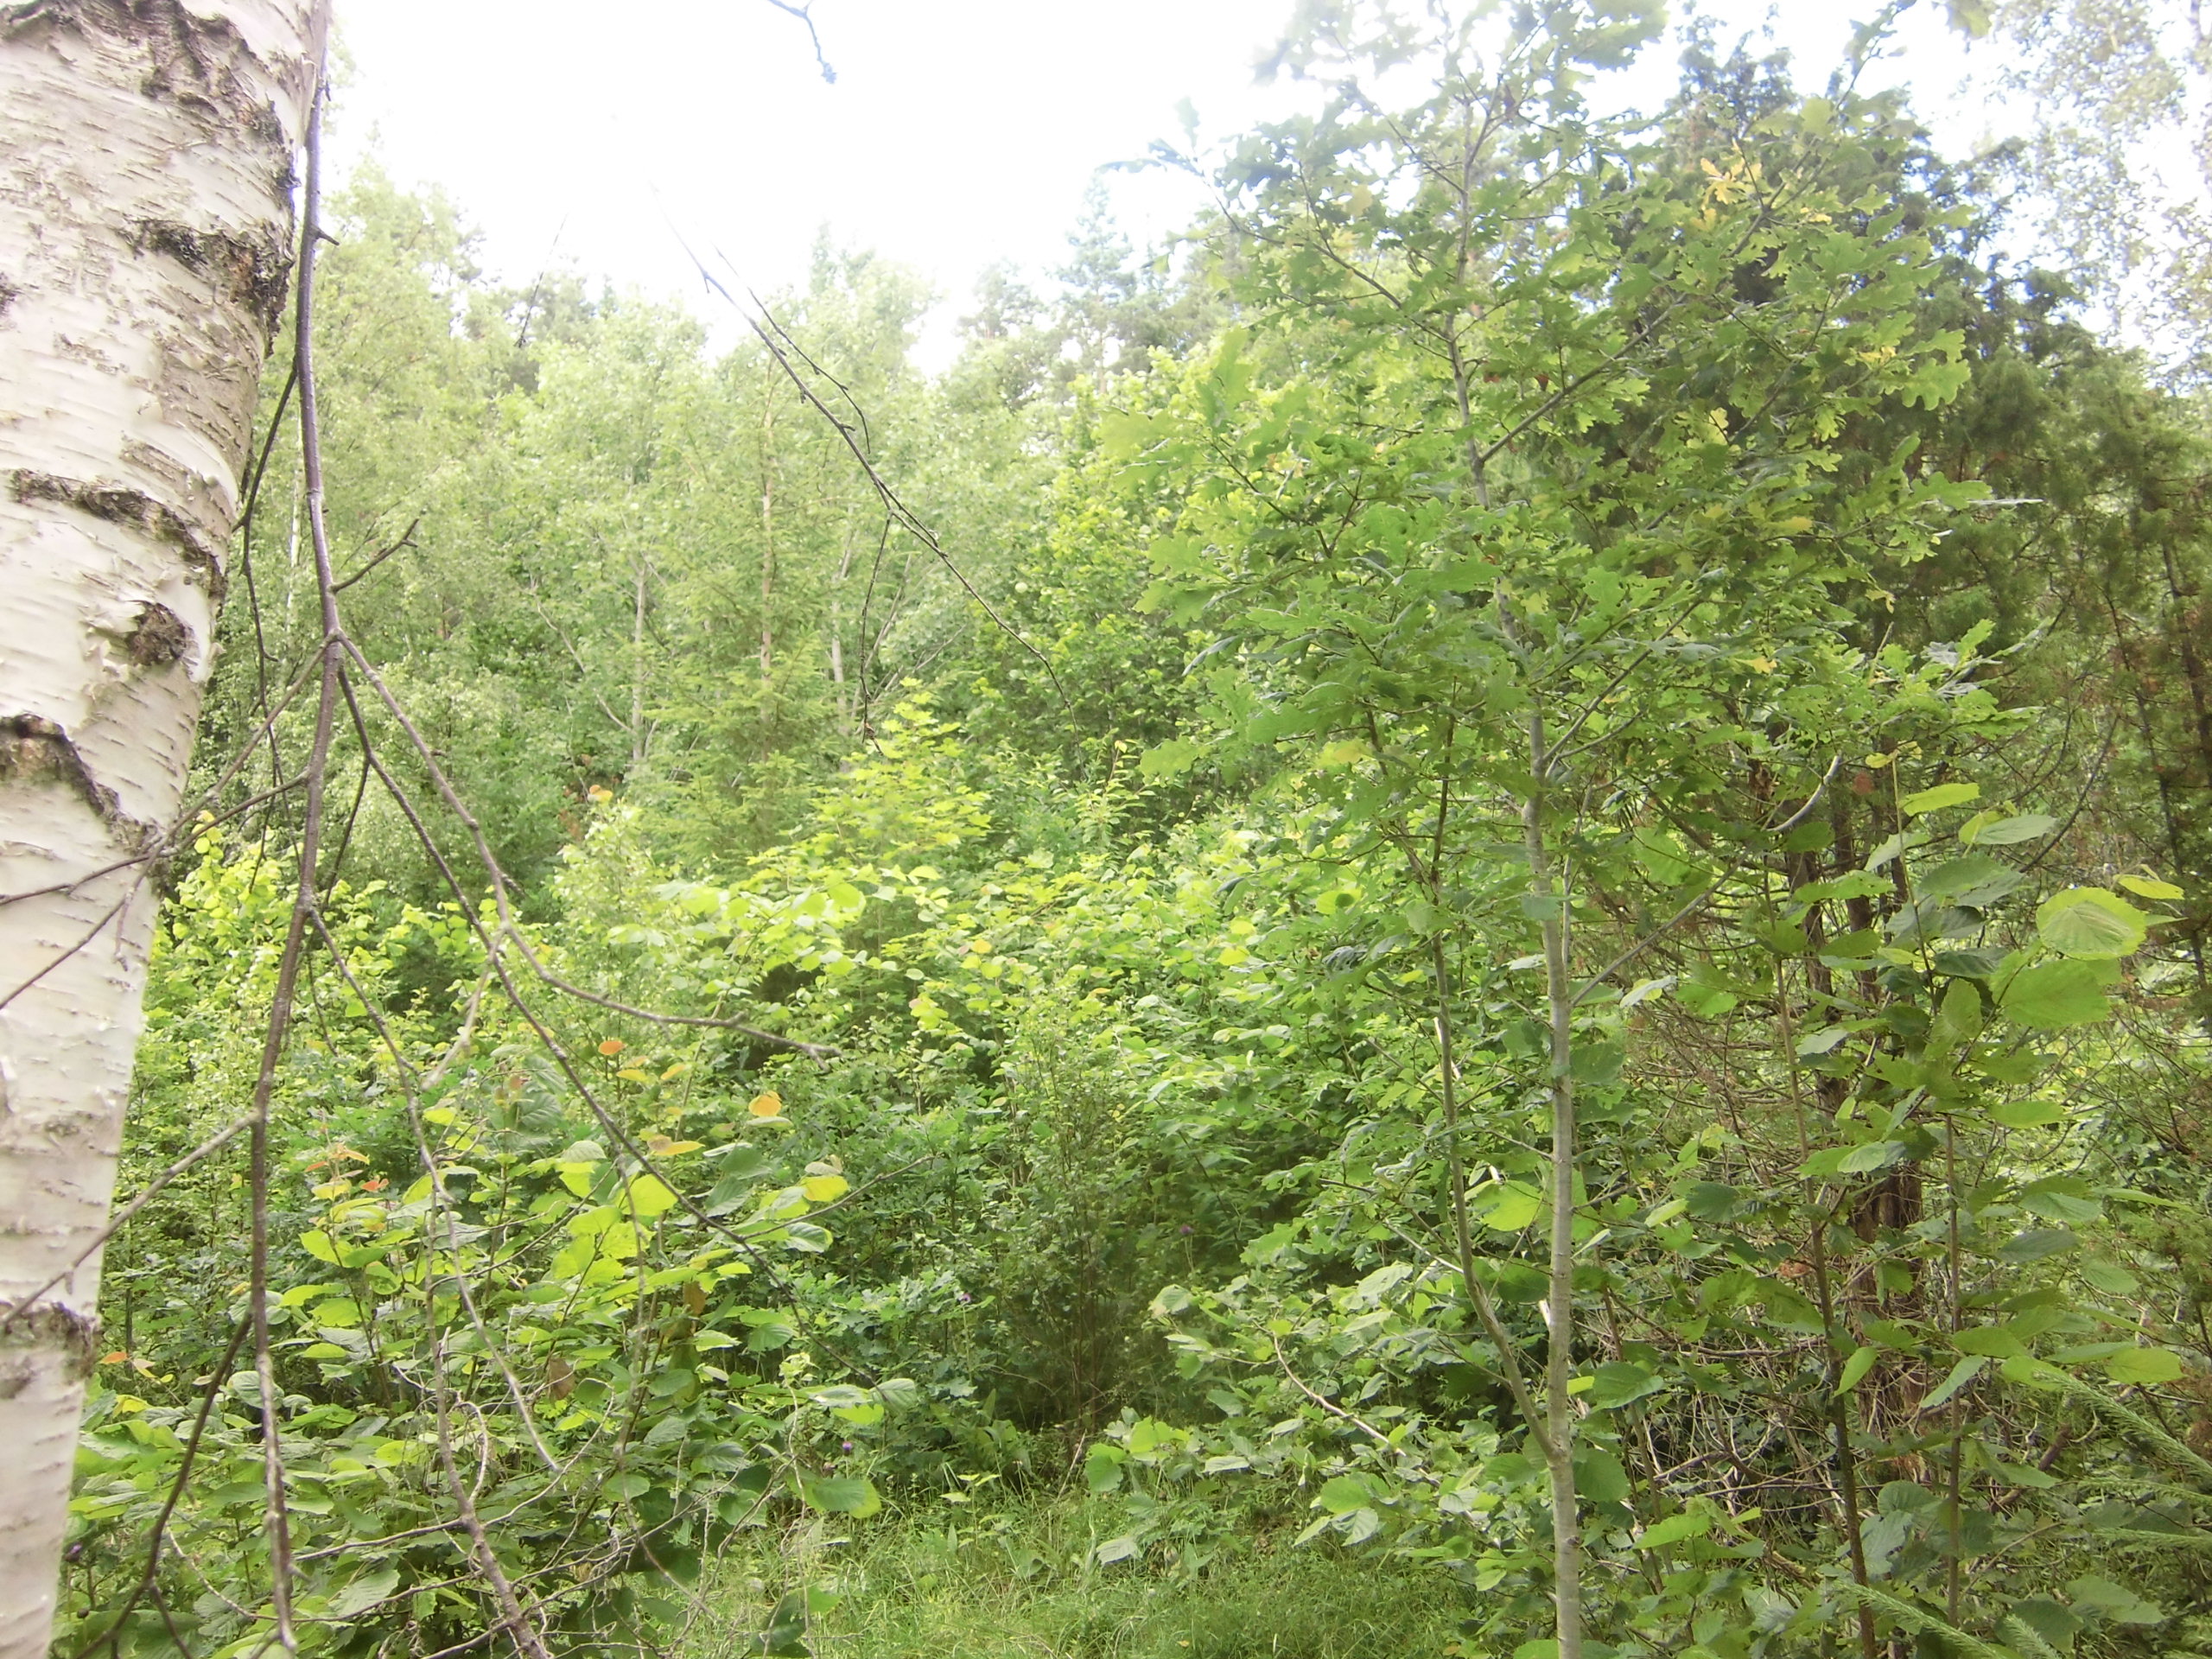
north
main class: Woodland
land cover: Broadleaved woodland
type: hemiboreal forest and nemoral coniferous forest and mixed broadleaved-coniferous forest
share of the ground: 50 - 75 %
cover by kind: broadleaved forest trees 55 %, herbaceous plants 25 %, shrubs 10 %, coniferous forest trees 5 %, lichens and mosses 5 %
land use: Forestry
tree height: > 5 m
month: July
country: SE
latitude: 57.2202
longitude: 15.5785
